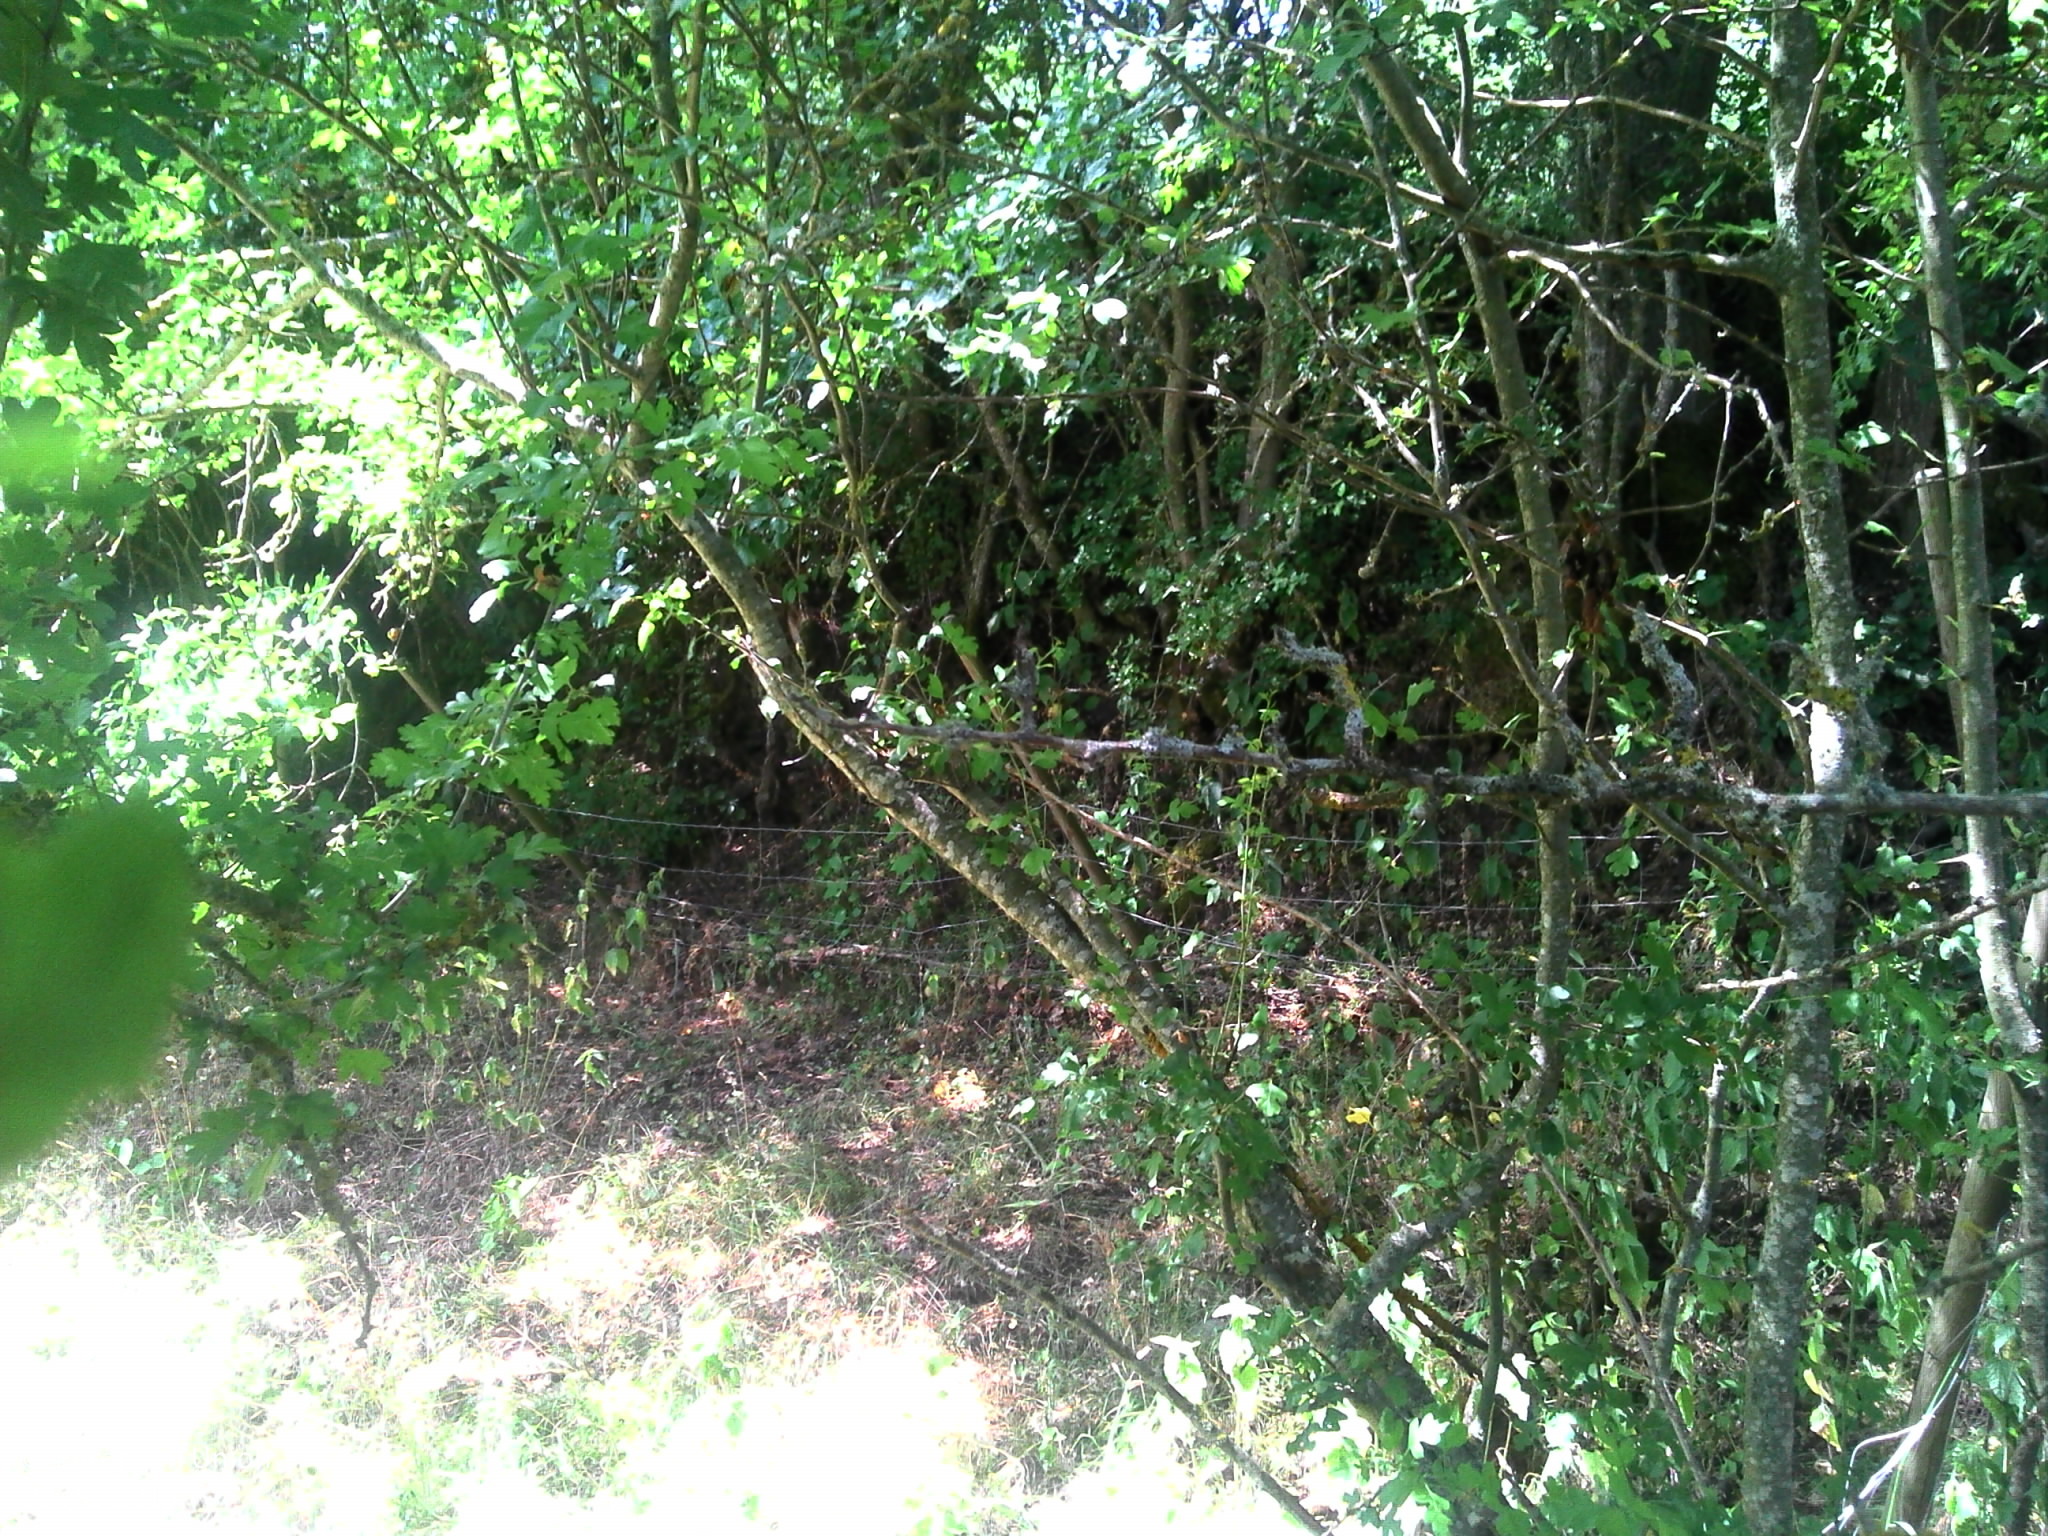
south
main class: Woodland
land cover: Broadleaved woodland
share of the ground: > 75 %
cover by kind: broadleaved forest trees 60 %, shrubs 30 %, herbaceous plants 10 %
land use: Semi-natural and natural areas not in use
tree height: > 5 m
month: July
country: FR
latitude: 45.1432
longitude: 2.9687
